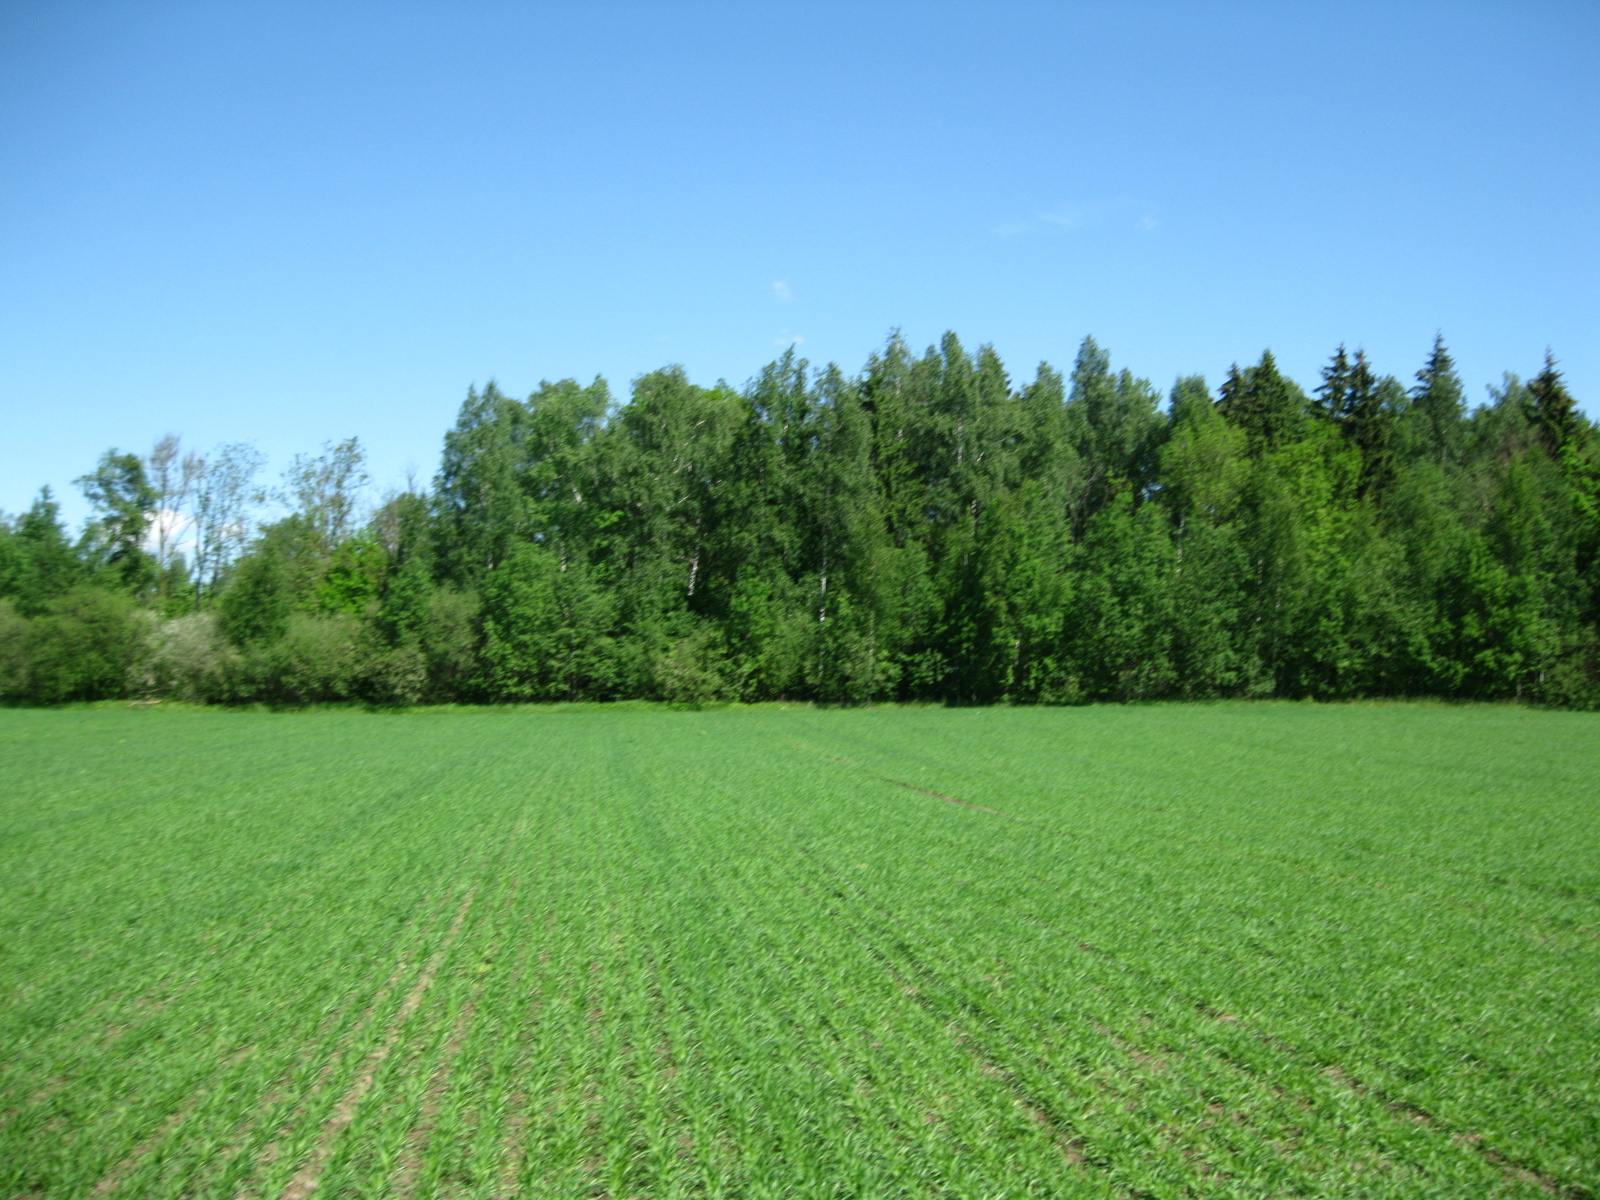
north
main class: Cropland
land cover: Barley
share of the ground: 50 - 75 %
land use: Agriculture (excluding fallow land and kitchen gardens)
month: May
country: LT
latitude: 55.7797
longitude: 24.3333
